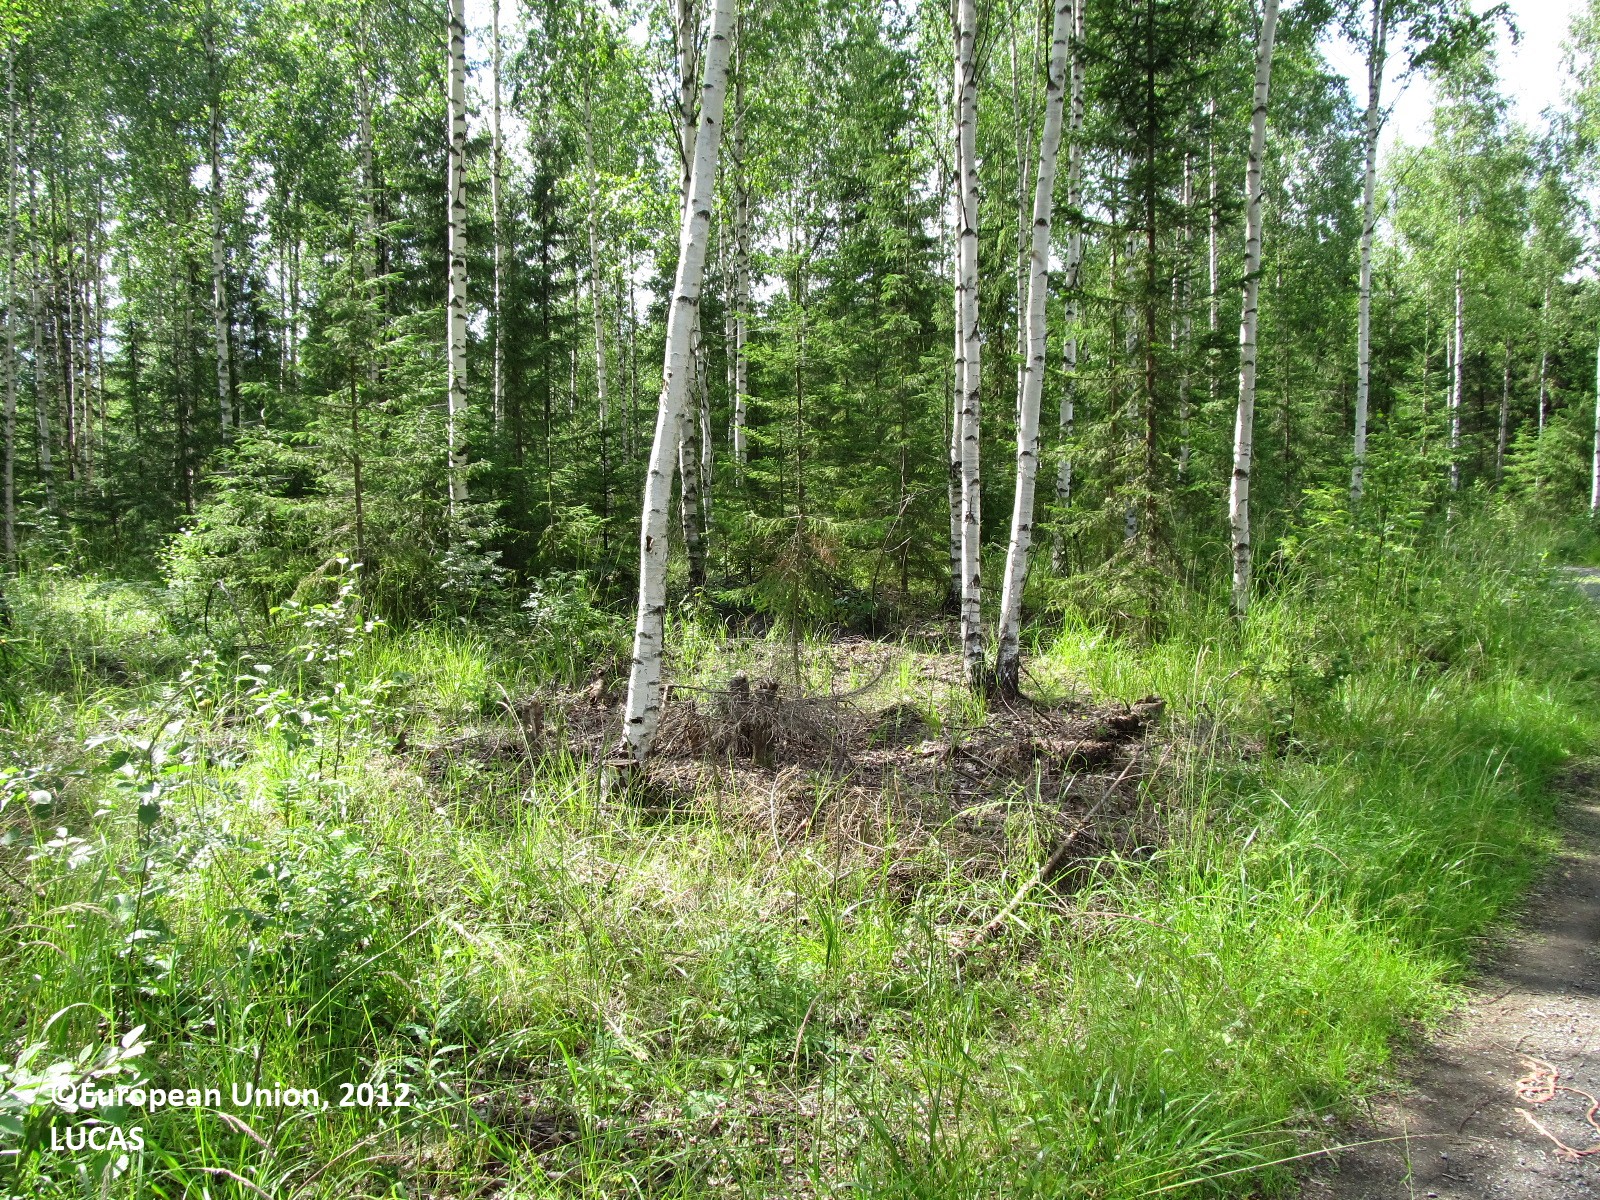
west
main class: Woodland
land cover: Spruce dominated mixed woodland
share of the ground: 25 - 50 %
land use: Forestry
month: July
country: FI
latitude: 61.9323
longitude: 28.3585
